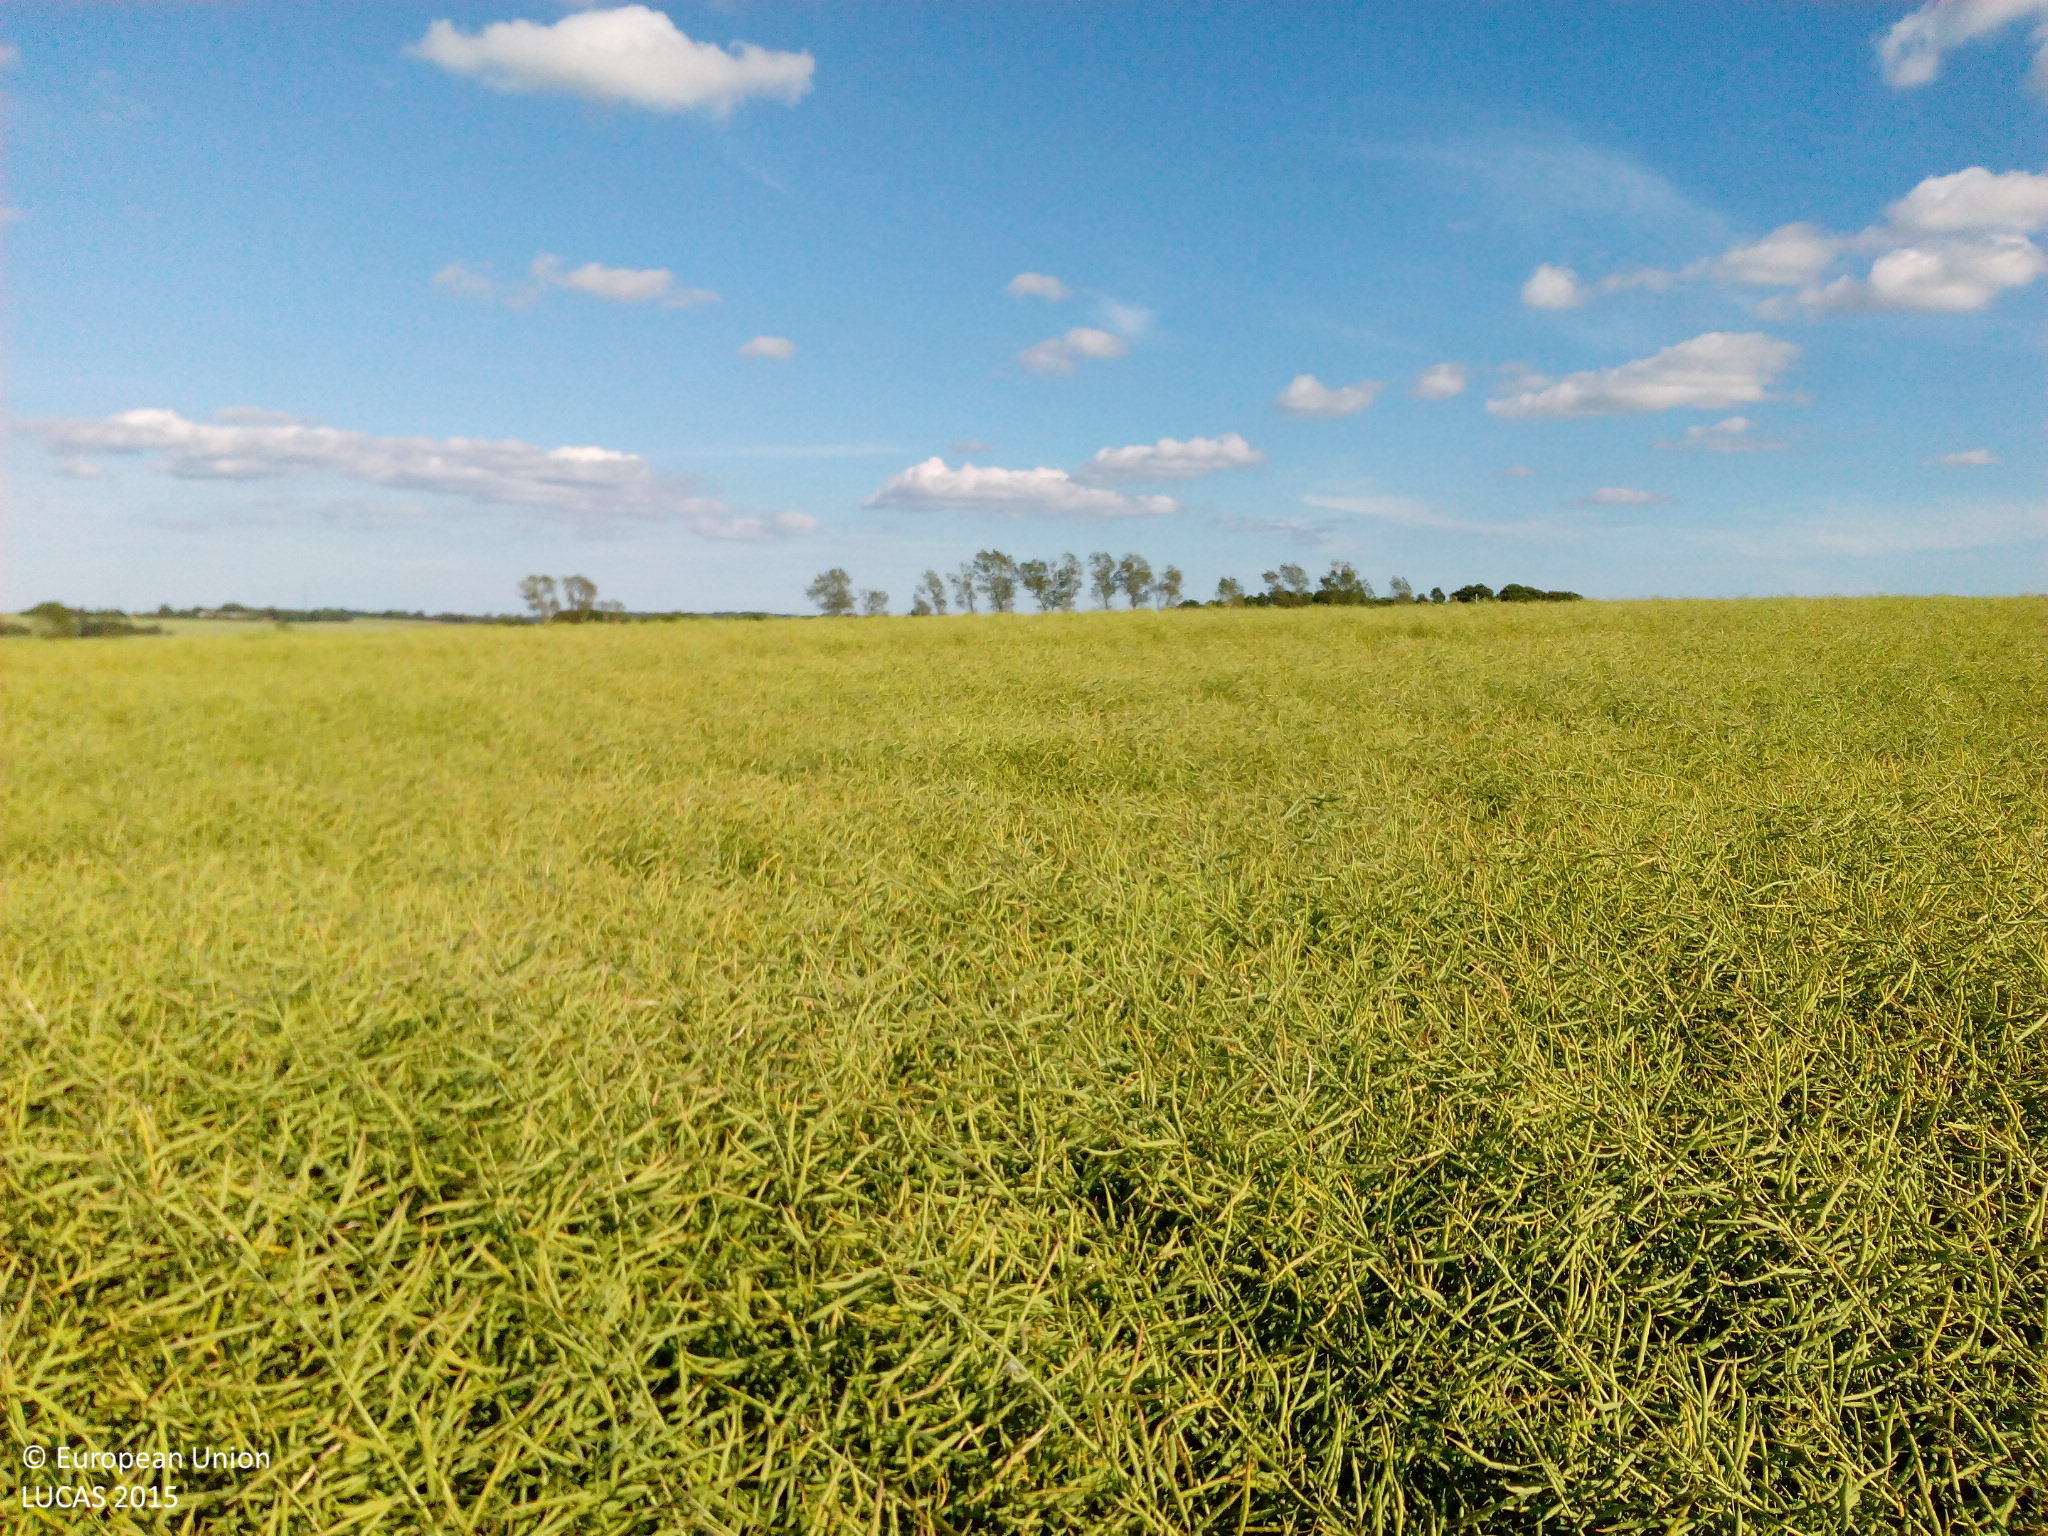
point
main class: Cropland
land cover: Rape and turnip rape
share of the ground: > 75 %
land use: Agriculture (excluding fallow land and kitchen gardens)
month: June
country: DK
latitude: 56.3298
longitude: 10.6623
